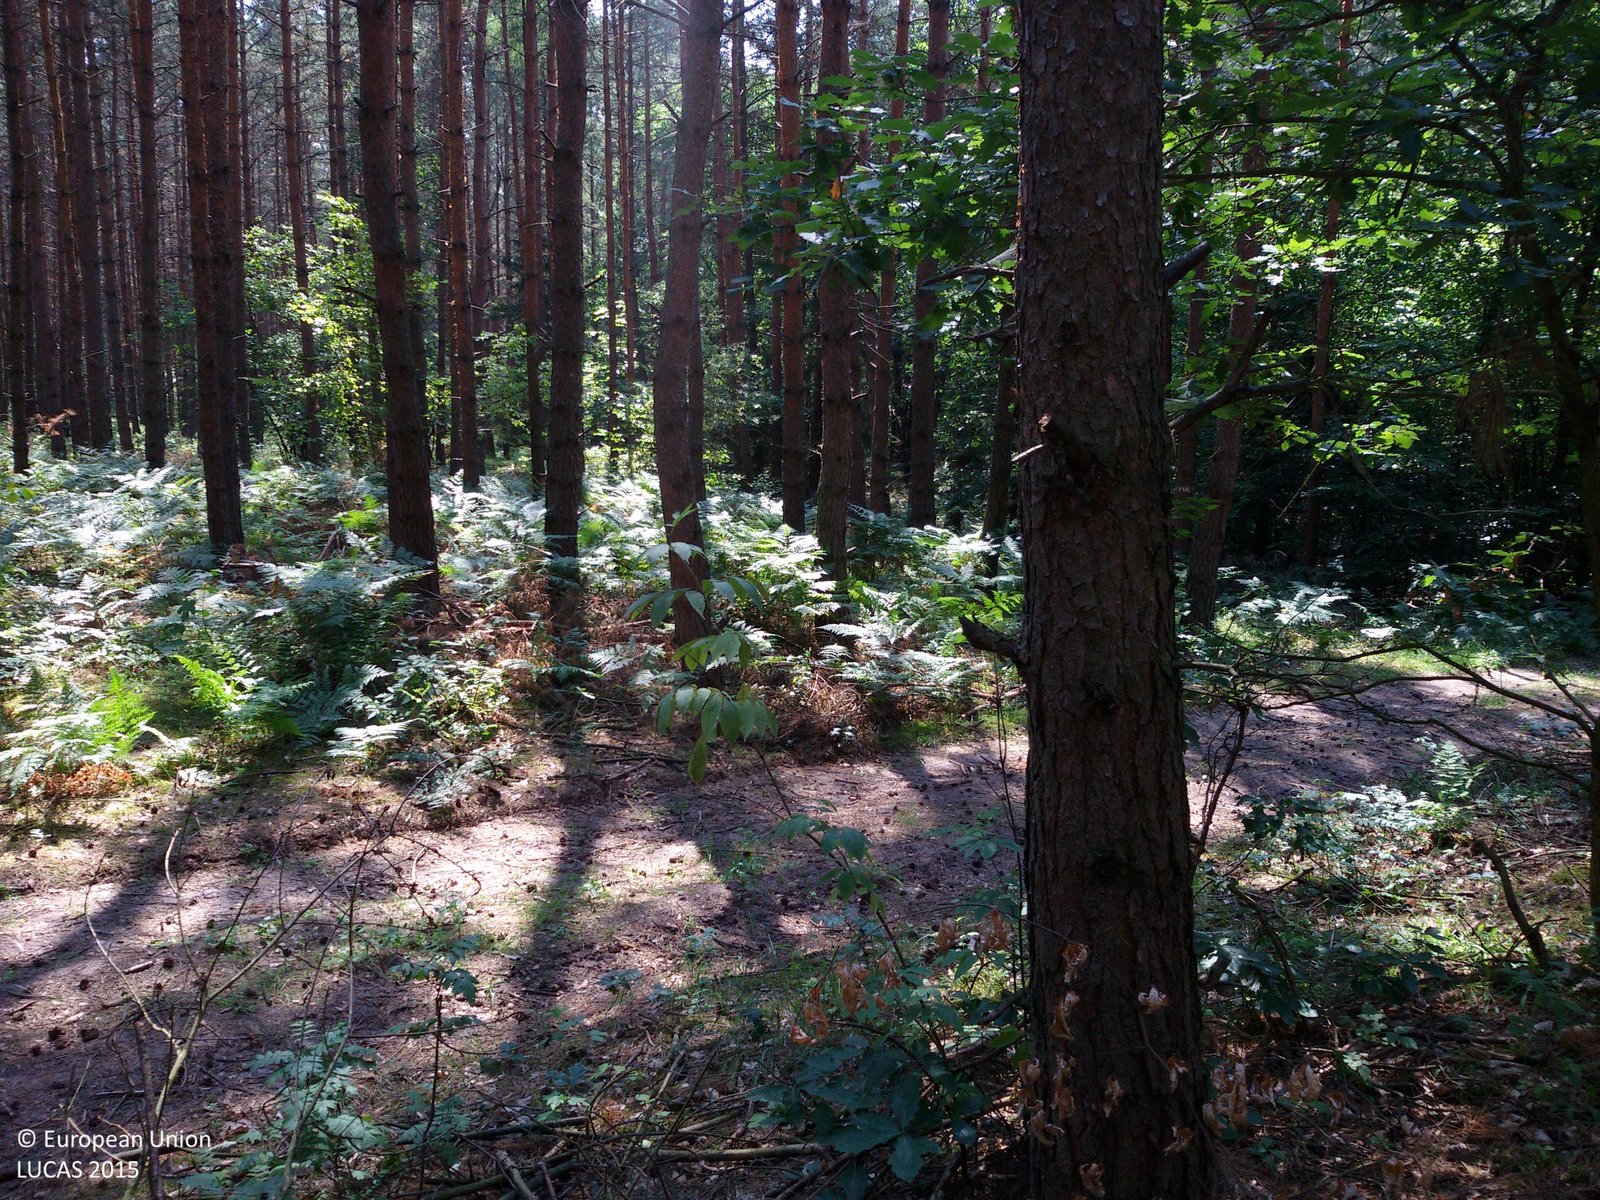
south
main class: Woodland
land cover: Pine dominated coniferous woodland
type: hemiboreal forest and nemoral coniferous forest and mixed broadleaved-coniferous forest
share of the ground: > 75 %
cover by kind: coniferous forest trees 100 %
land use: Forestry
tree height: > 5 m
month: July
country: PL
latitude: 53.2685
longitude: 17.6446
